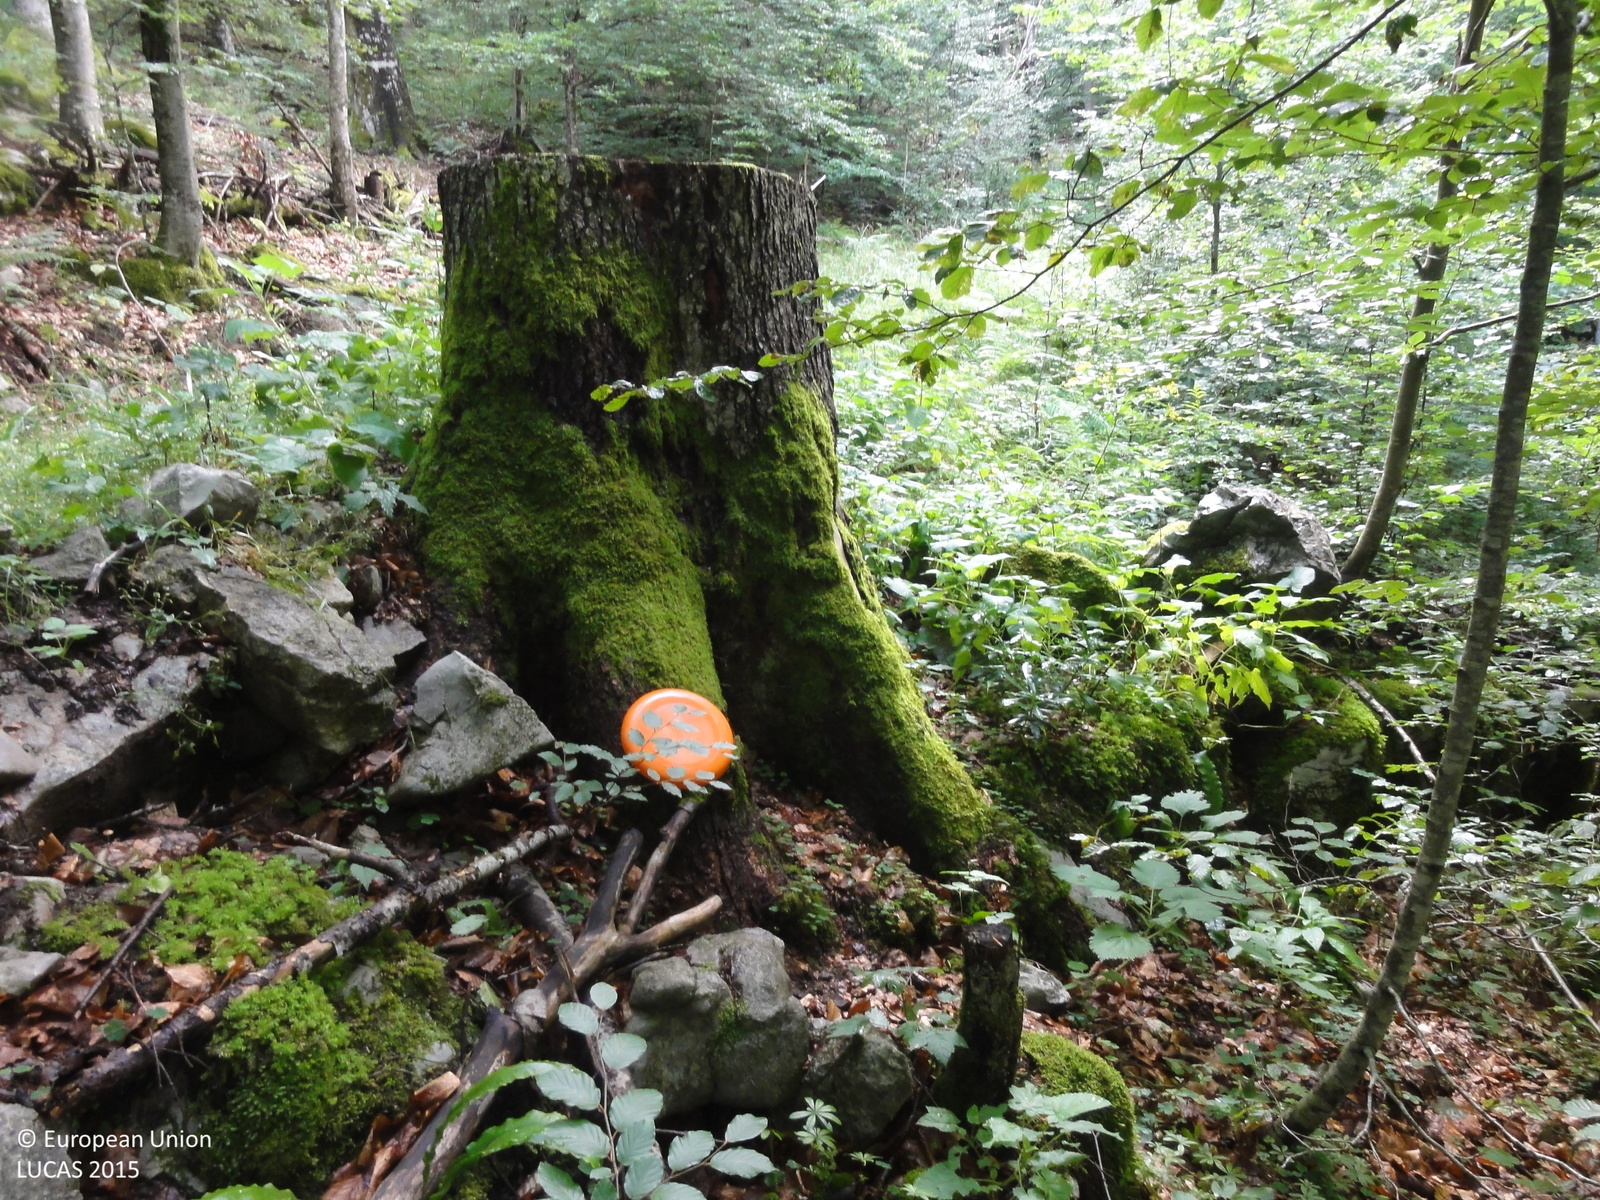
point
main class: Woodland
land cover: Spruce dominated mixed woodland
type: mountainous beech forest
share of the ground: > 75 %
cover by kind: broadleaved forest trees 60 %, coniferous forest trees 25 %, herbaceous plants 10 %, shrubs 5 %
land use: Forestry
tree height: > 5 m
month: July
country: SI
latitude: 45.6296
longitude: 14.8060
